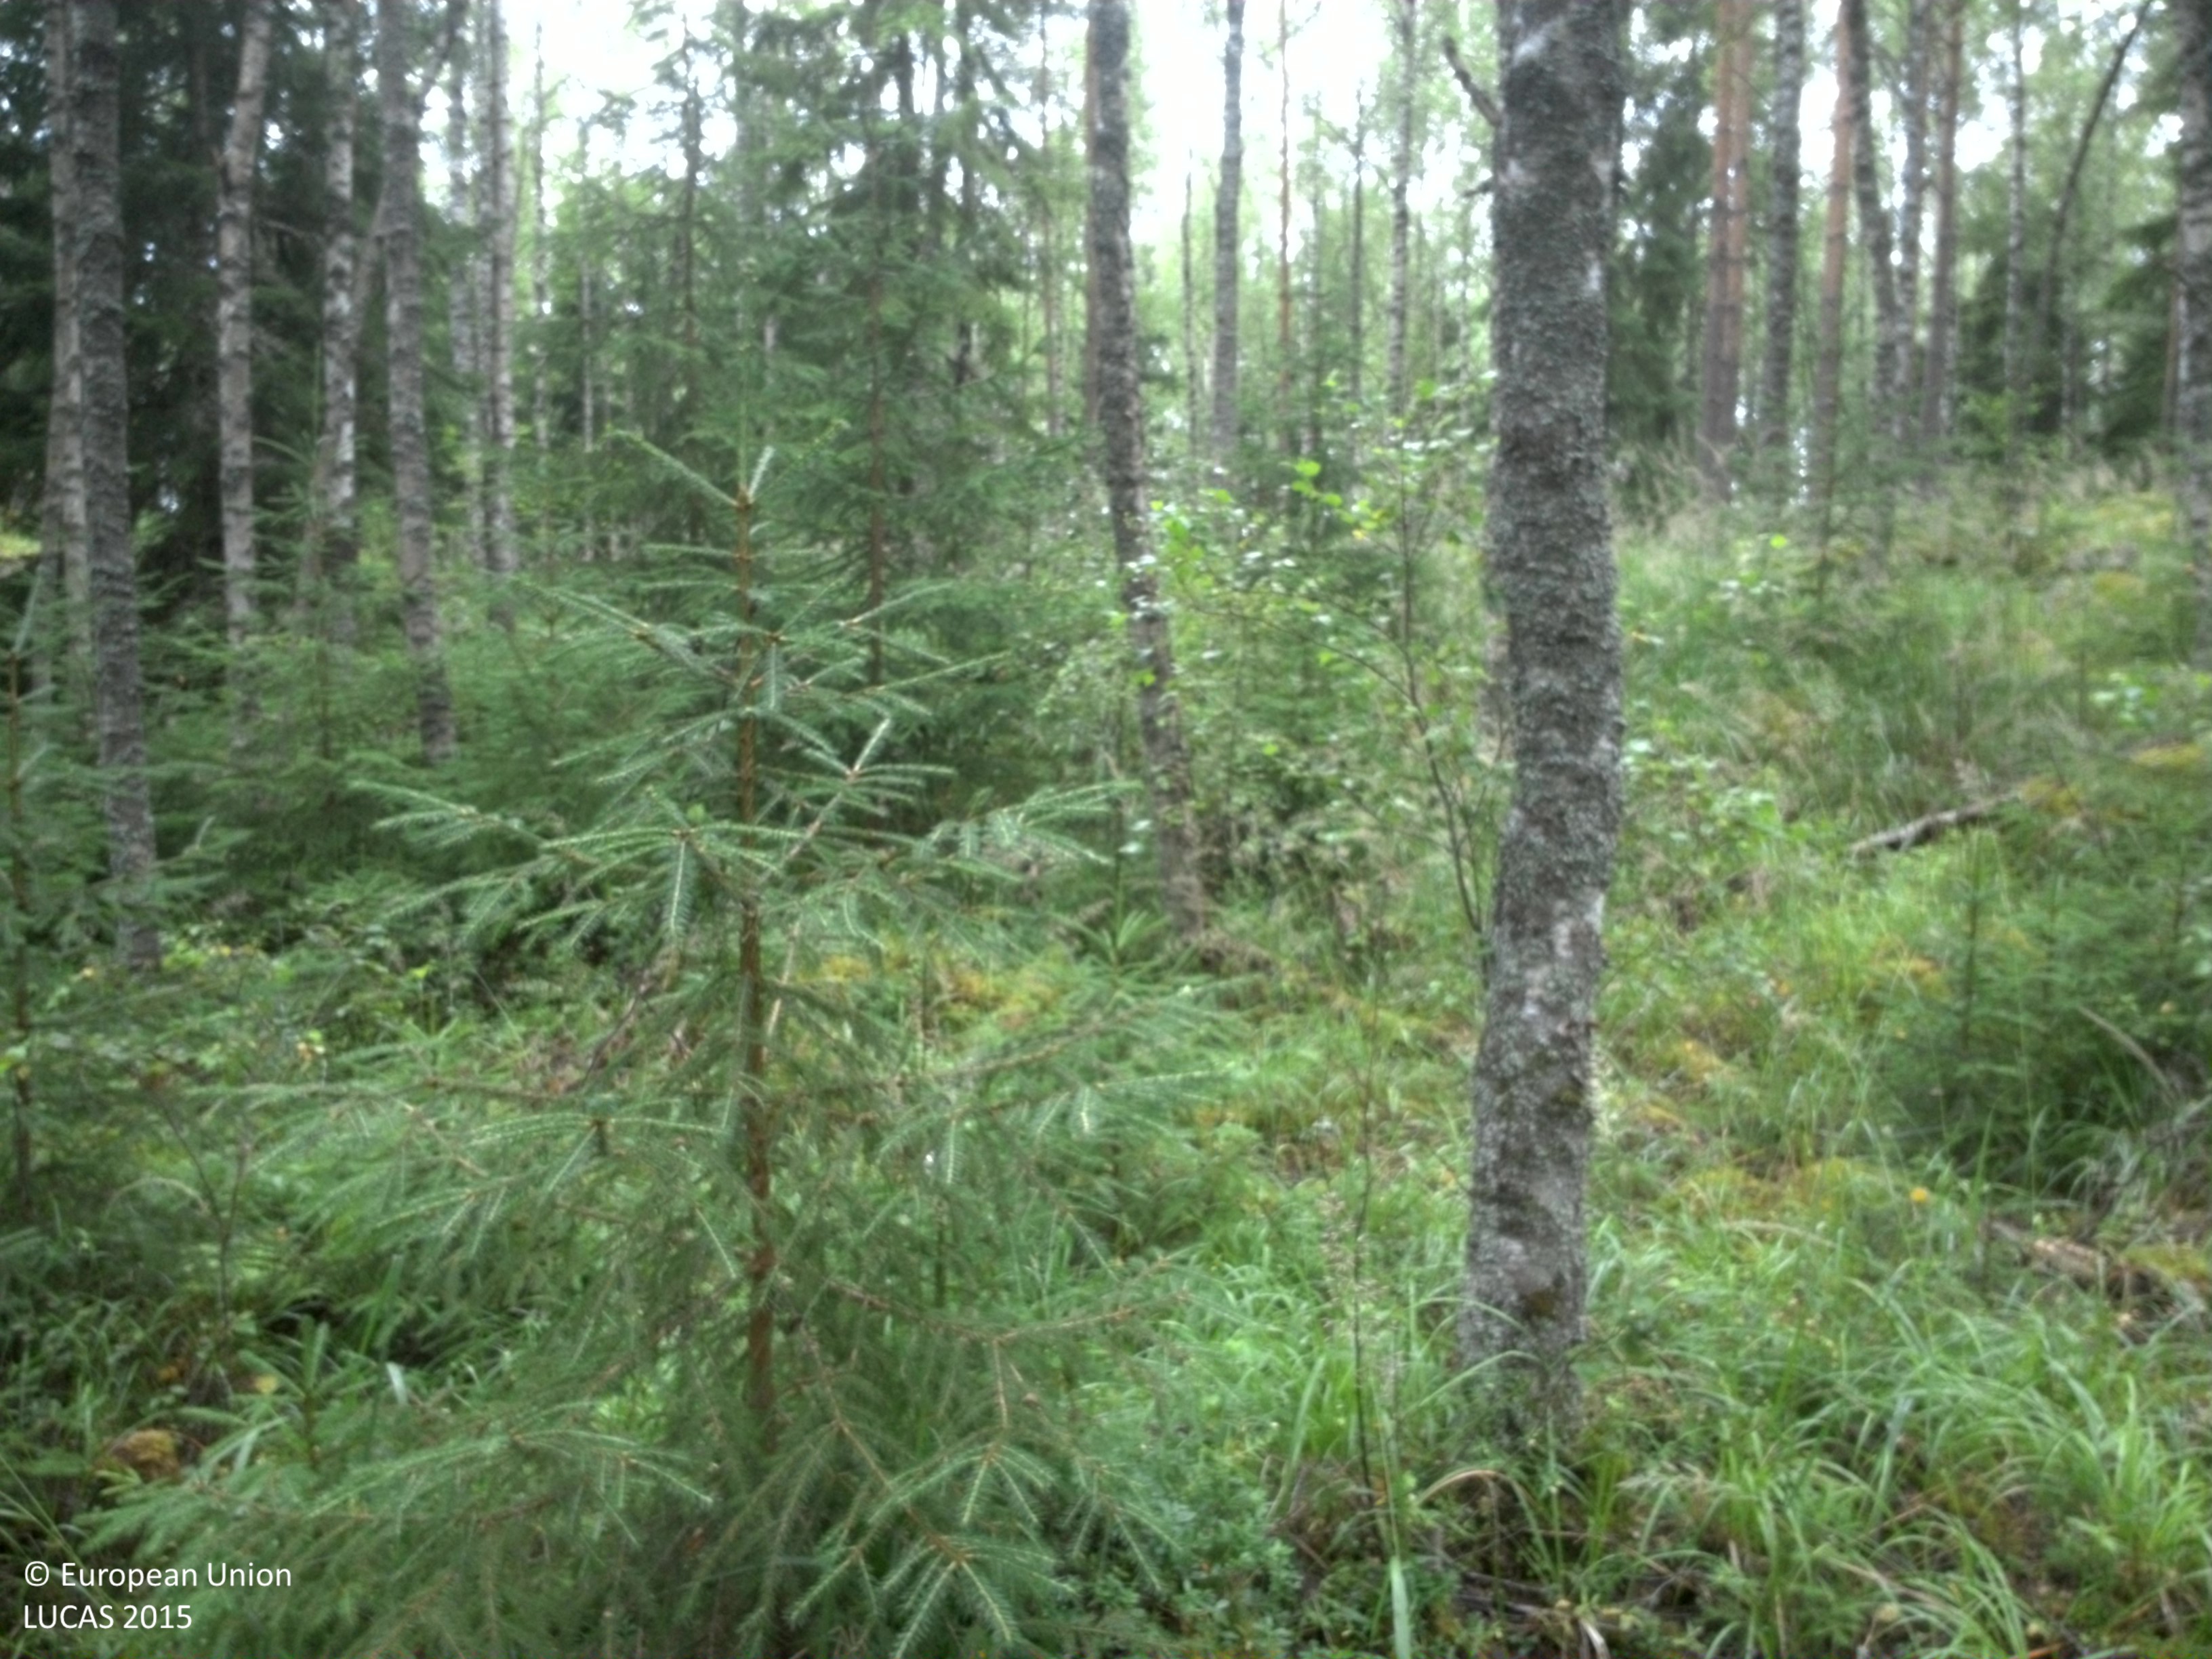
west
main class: Woodland
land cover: Other mixed woodland
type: boreal forest
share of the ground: > 75 %
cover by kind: broadleaved forest trees 45 %, coniferous forest trees 30 %, herbaceous plants 15 %, shrubs 5 %, lichens and mosses 5 %
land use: Forestry
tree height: > 5 m
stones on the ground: > 50 %
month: July
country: SE
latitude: 59.6855
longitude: 14.2002
